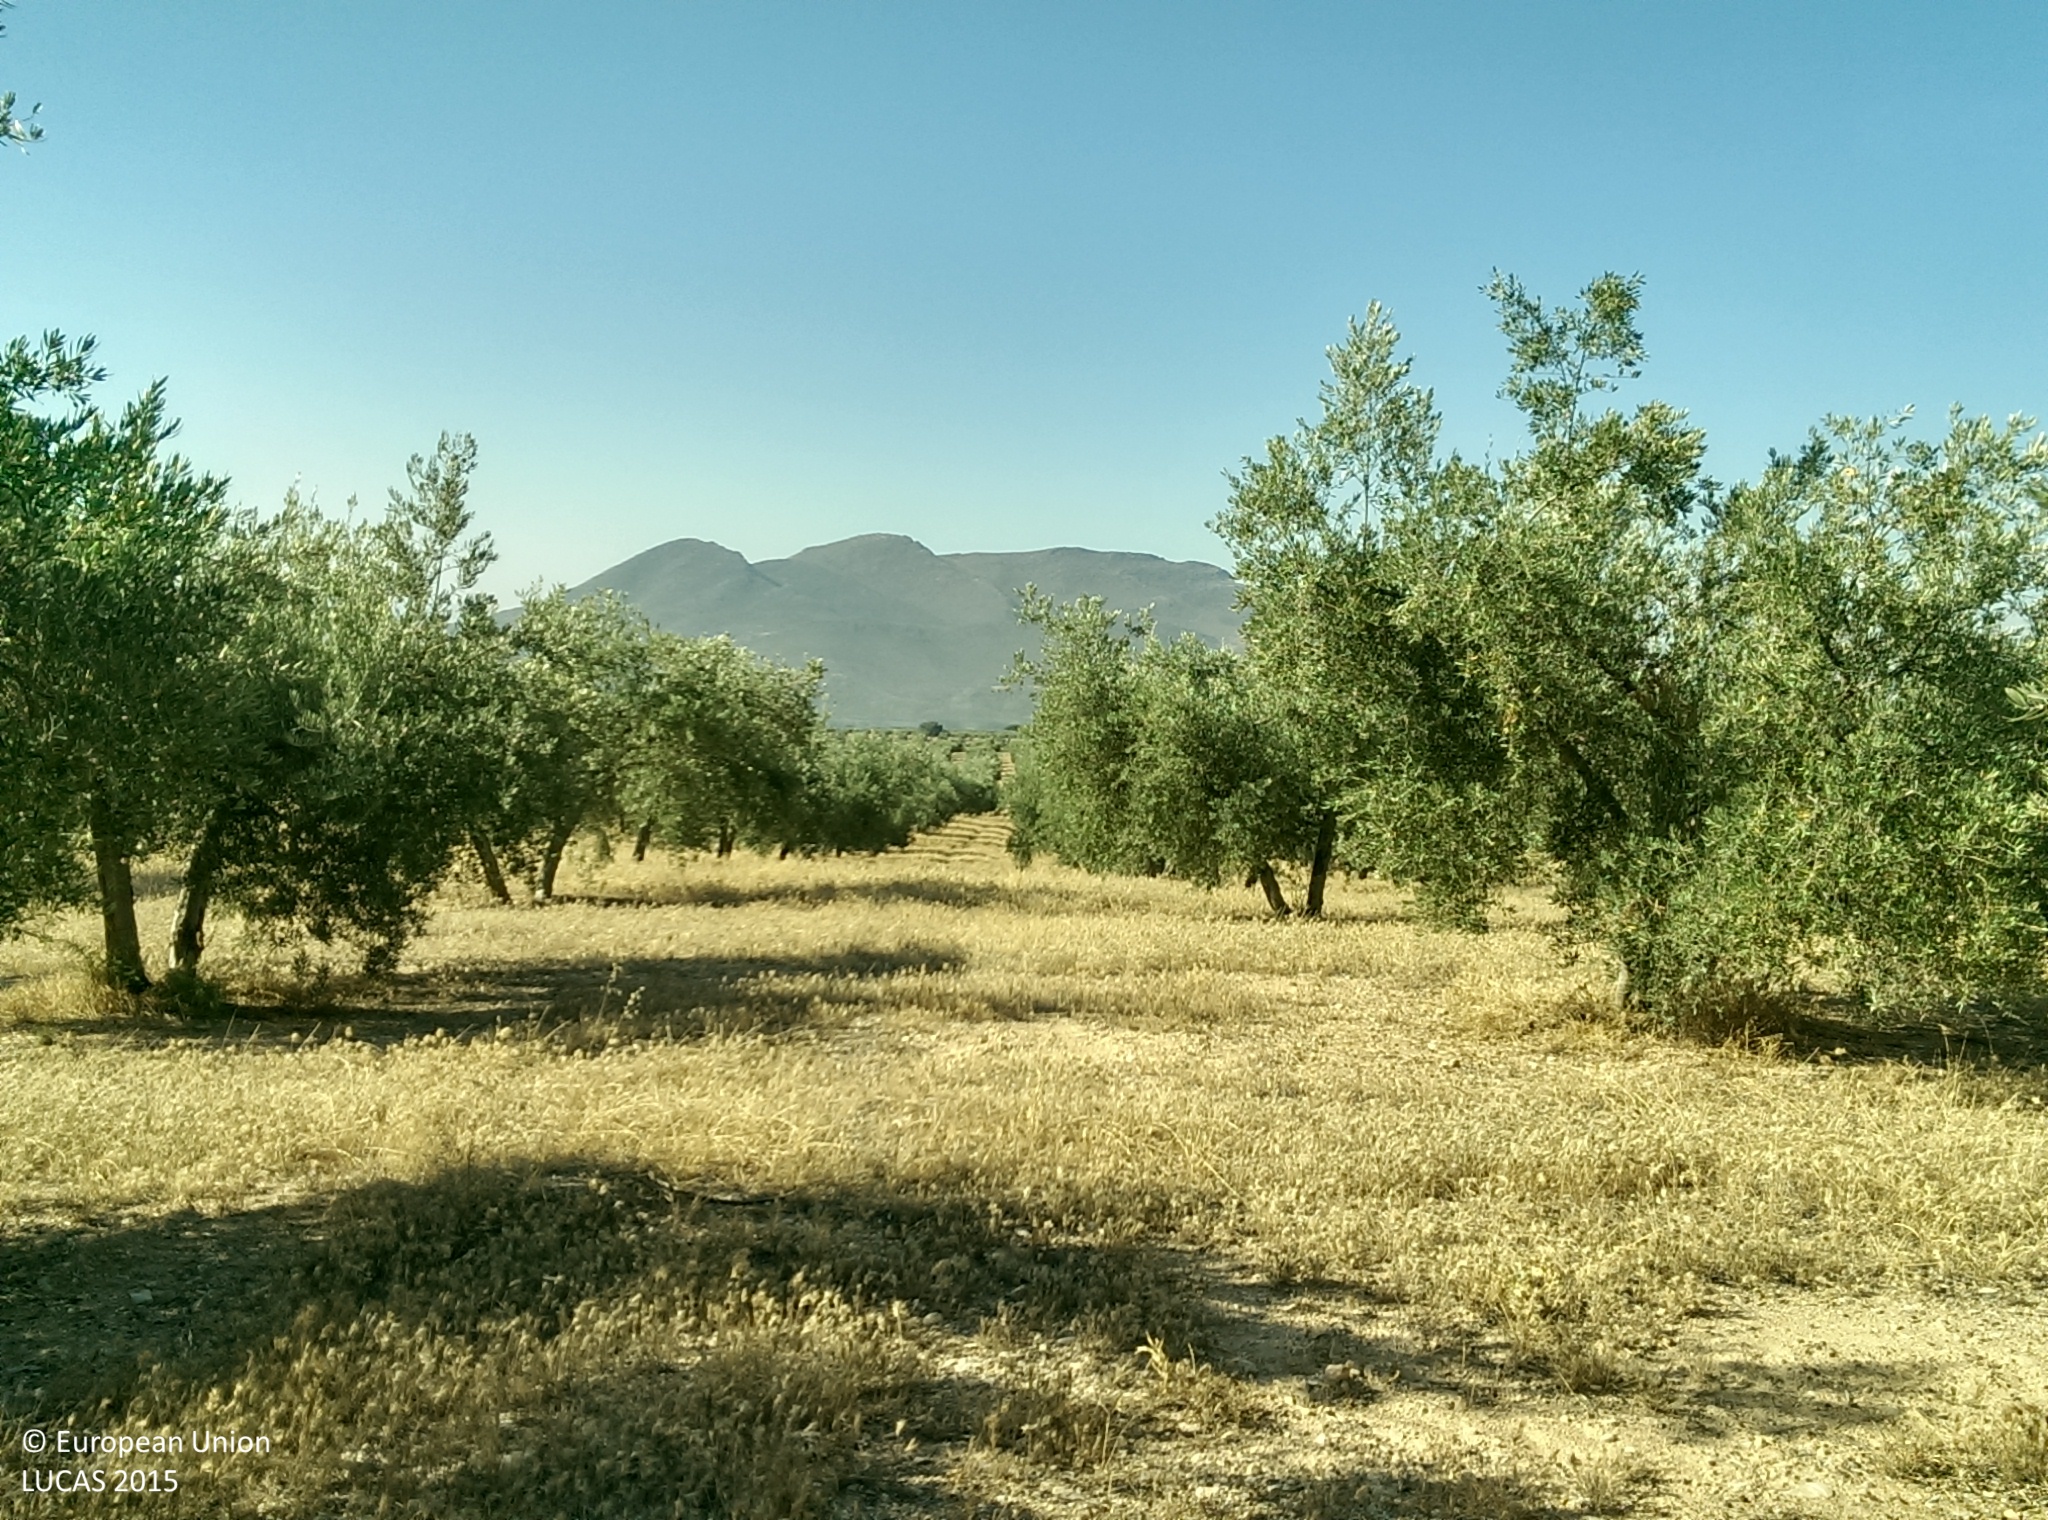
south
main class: Cropland
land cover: Olive groves
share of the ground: 25 - 50 %
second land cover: Spontaneously vegetated surfaces
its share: 25 - 50 %
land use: Agriculture (excluding fallow land and kitchen gardens)
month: July
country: ES
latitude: 37.2987
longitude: -3.7217
